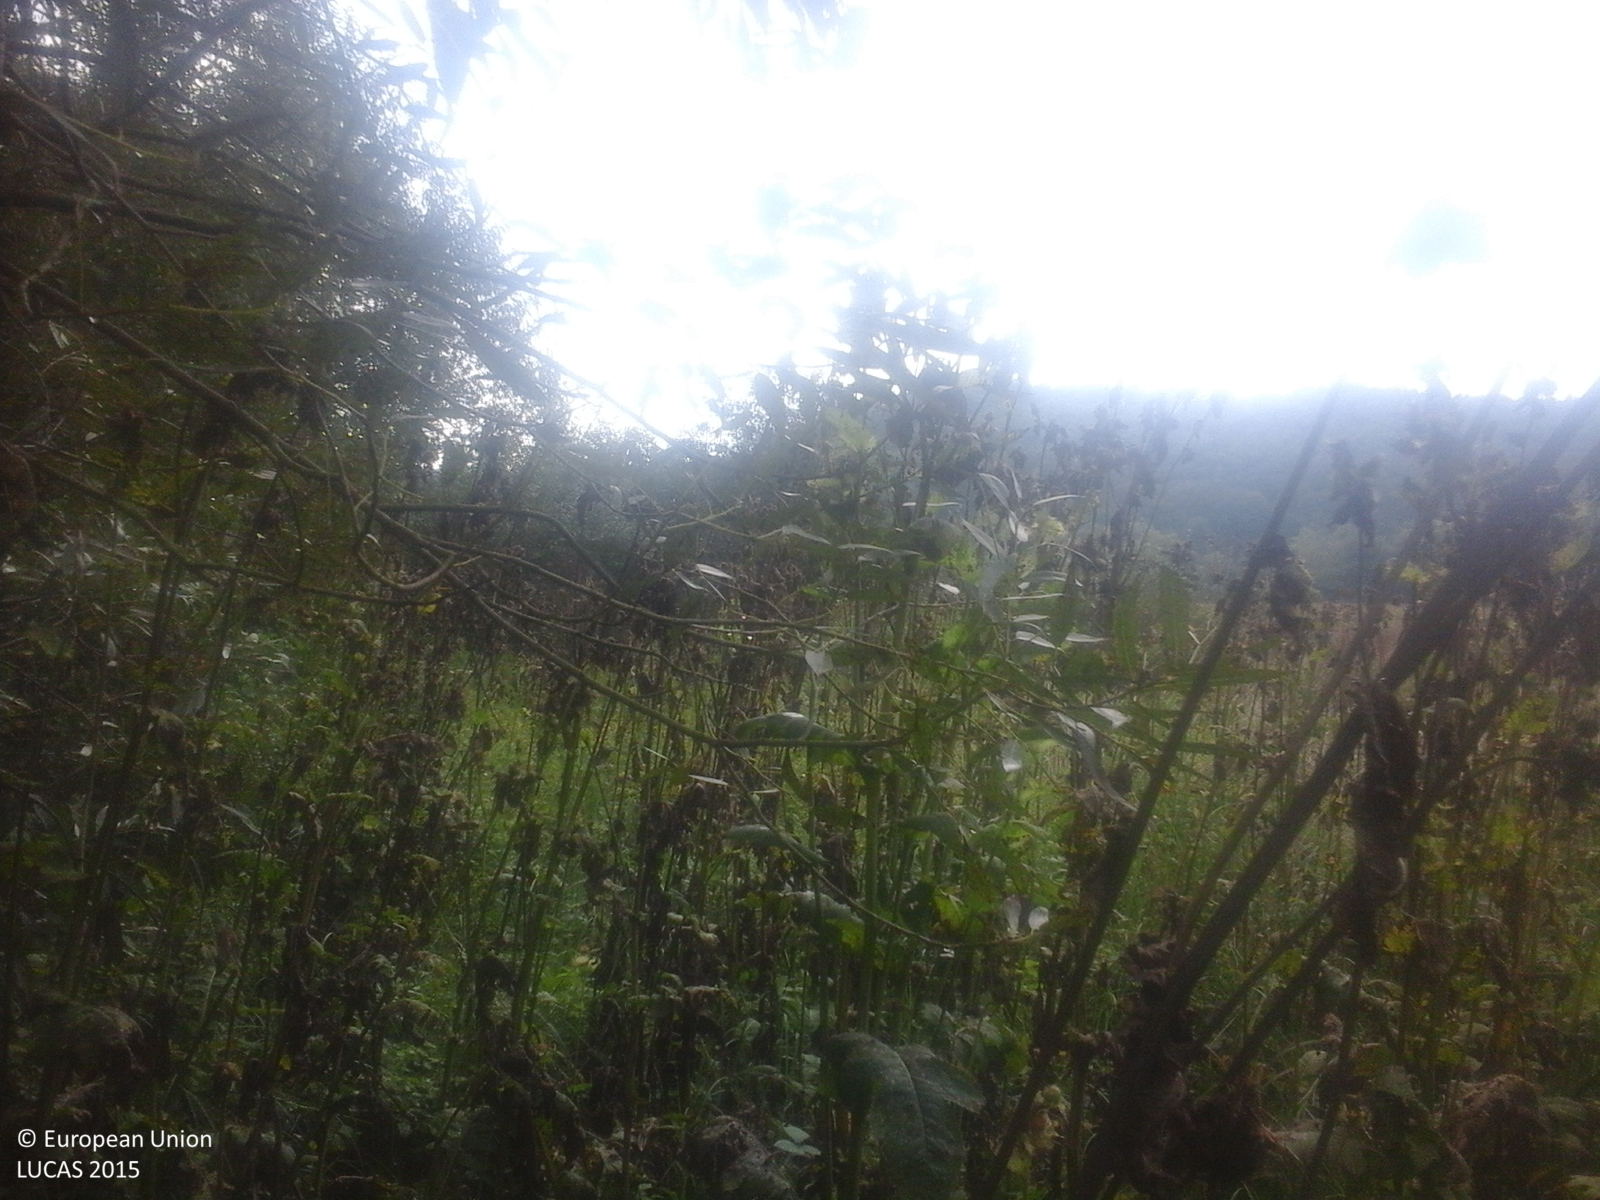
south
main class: Woodland
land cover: Broadleaved woodland
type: mesophytic deciduous forest
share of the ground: > 75 %
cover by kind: broadleaved forest trees 100 %
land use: Forestry
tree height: > 5 m
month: September
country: RO
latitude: 46.8388
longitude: 22.3101
